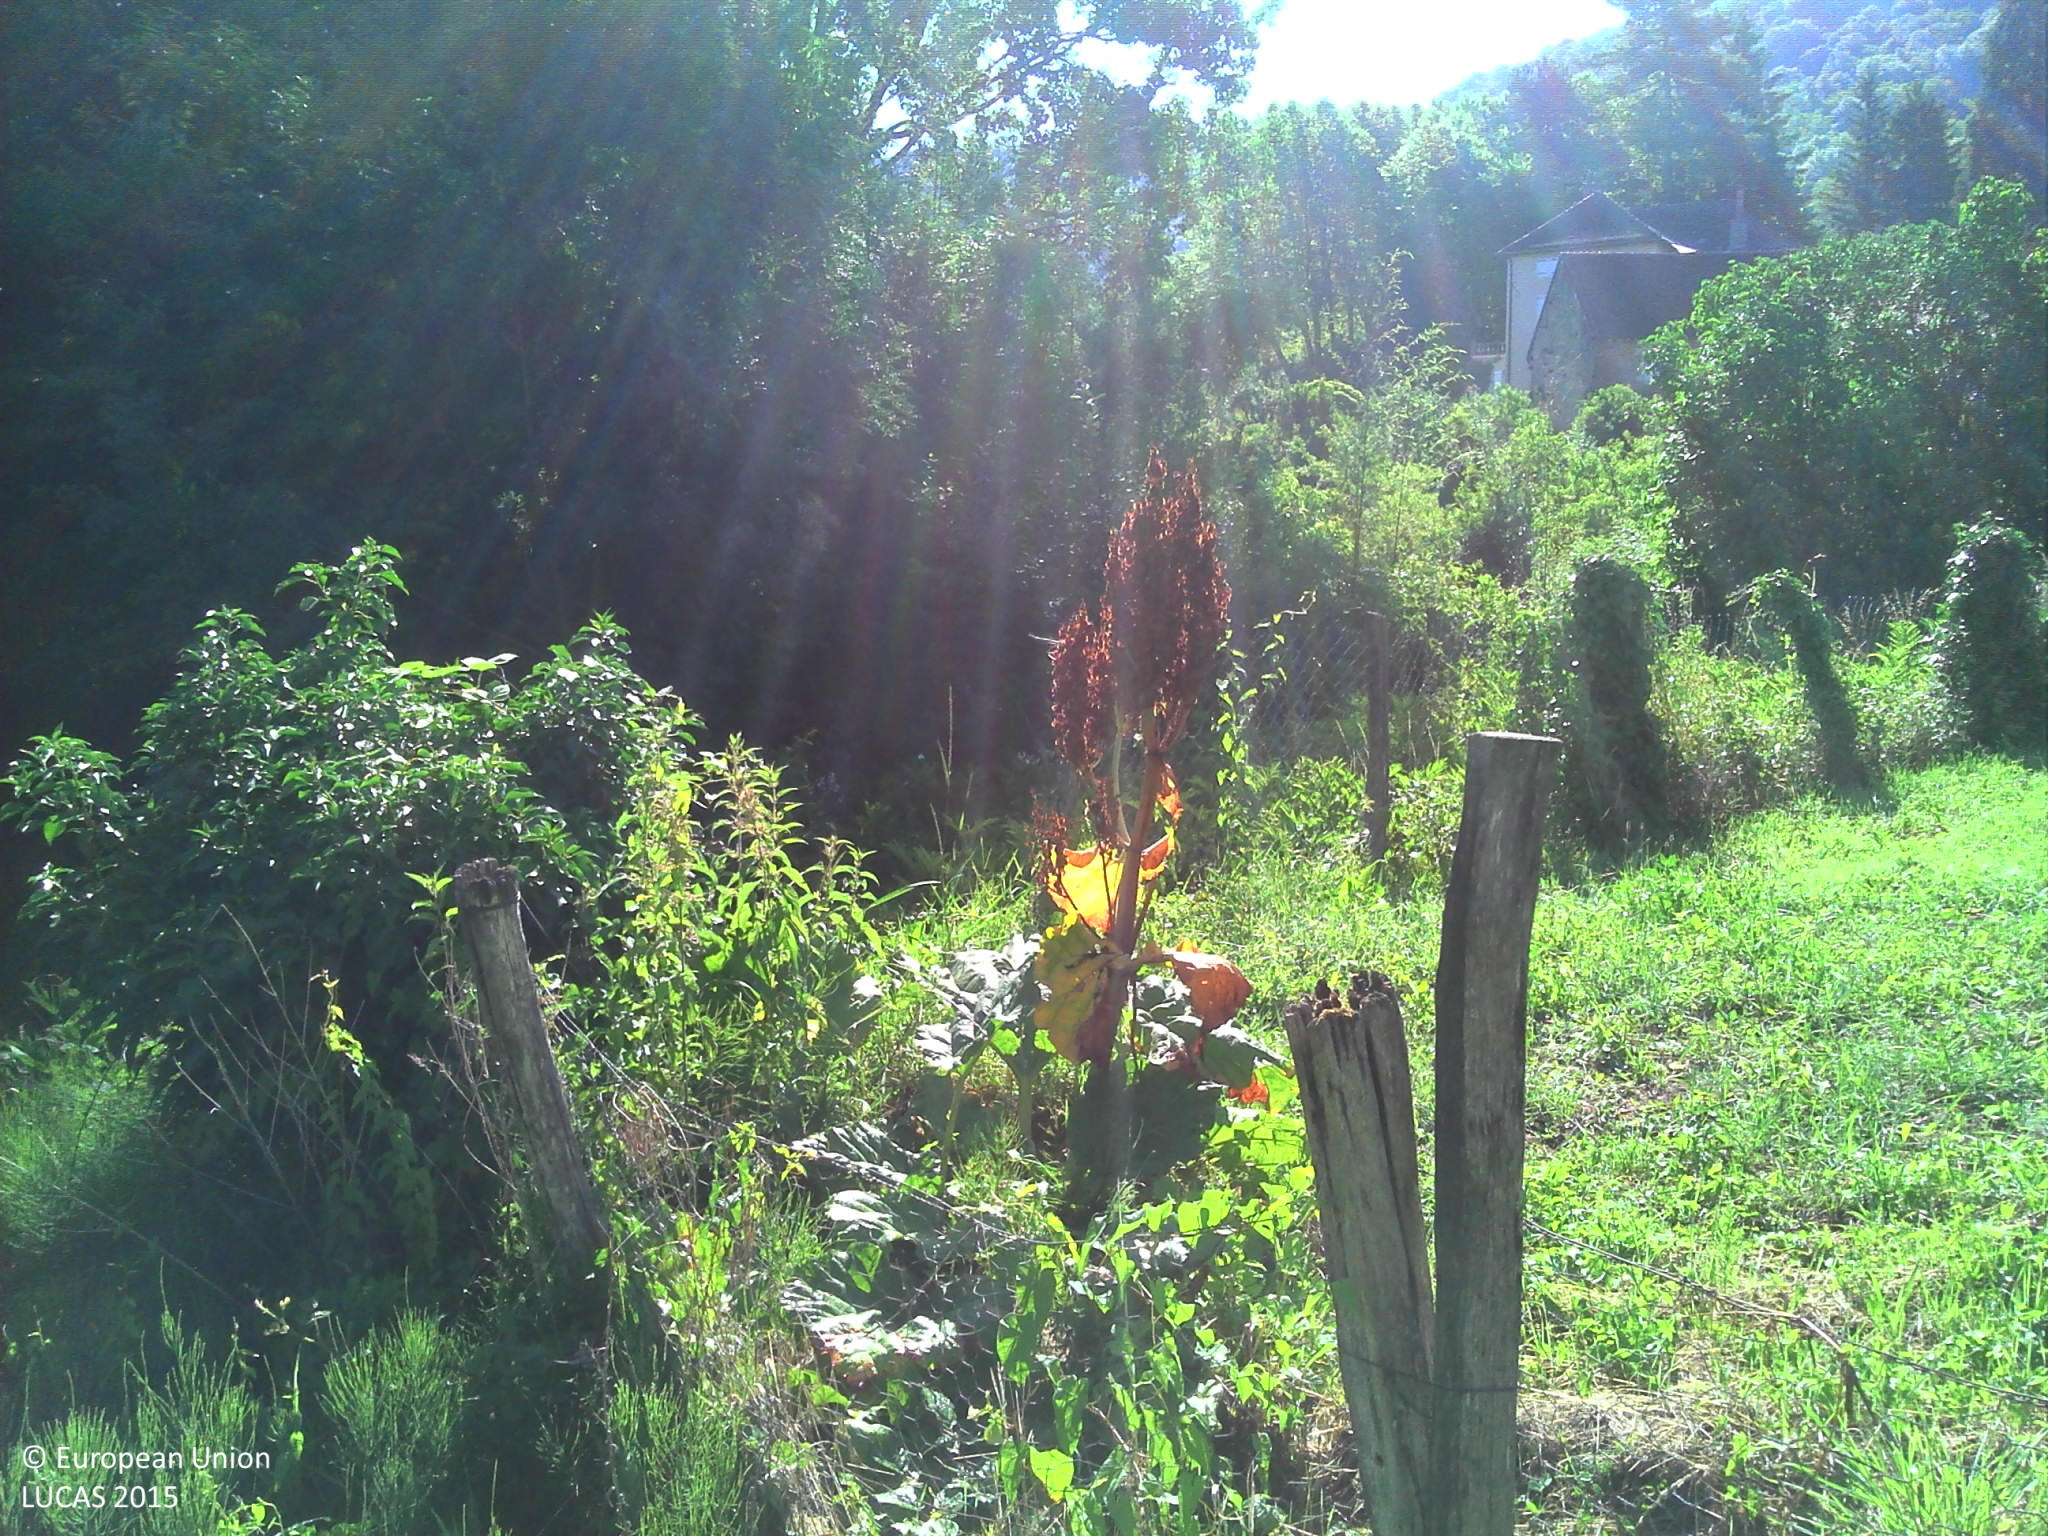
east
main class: Grassland
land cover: Spontaneously vegetated surfaces
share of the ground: > 75 %
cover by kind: herbaceous plants 100 %
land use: Residential
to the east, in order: Spontaneously vegetated surfaces; Fences; Spontaneously vegetated surfaces; Fences; Dry stone walls; Spontaneously vegetated surfaces; Abandoned hedges; Apple fruit; Fences; Grassland with sparse tree/shrub cover; Fences; Grassland without tree/shrub cover; Fences; Broadleaved woodland; Apple fruit; Fences; Grassland with sparse tree/shrub cover; Lines of trees; Ditches and canals; Abandoned hedges; Fences; Grassland without tree/shrub cover
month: June
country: FR
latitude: 46.5600
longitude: 5.4238
